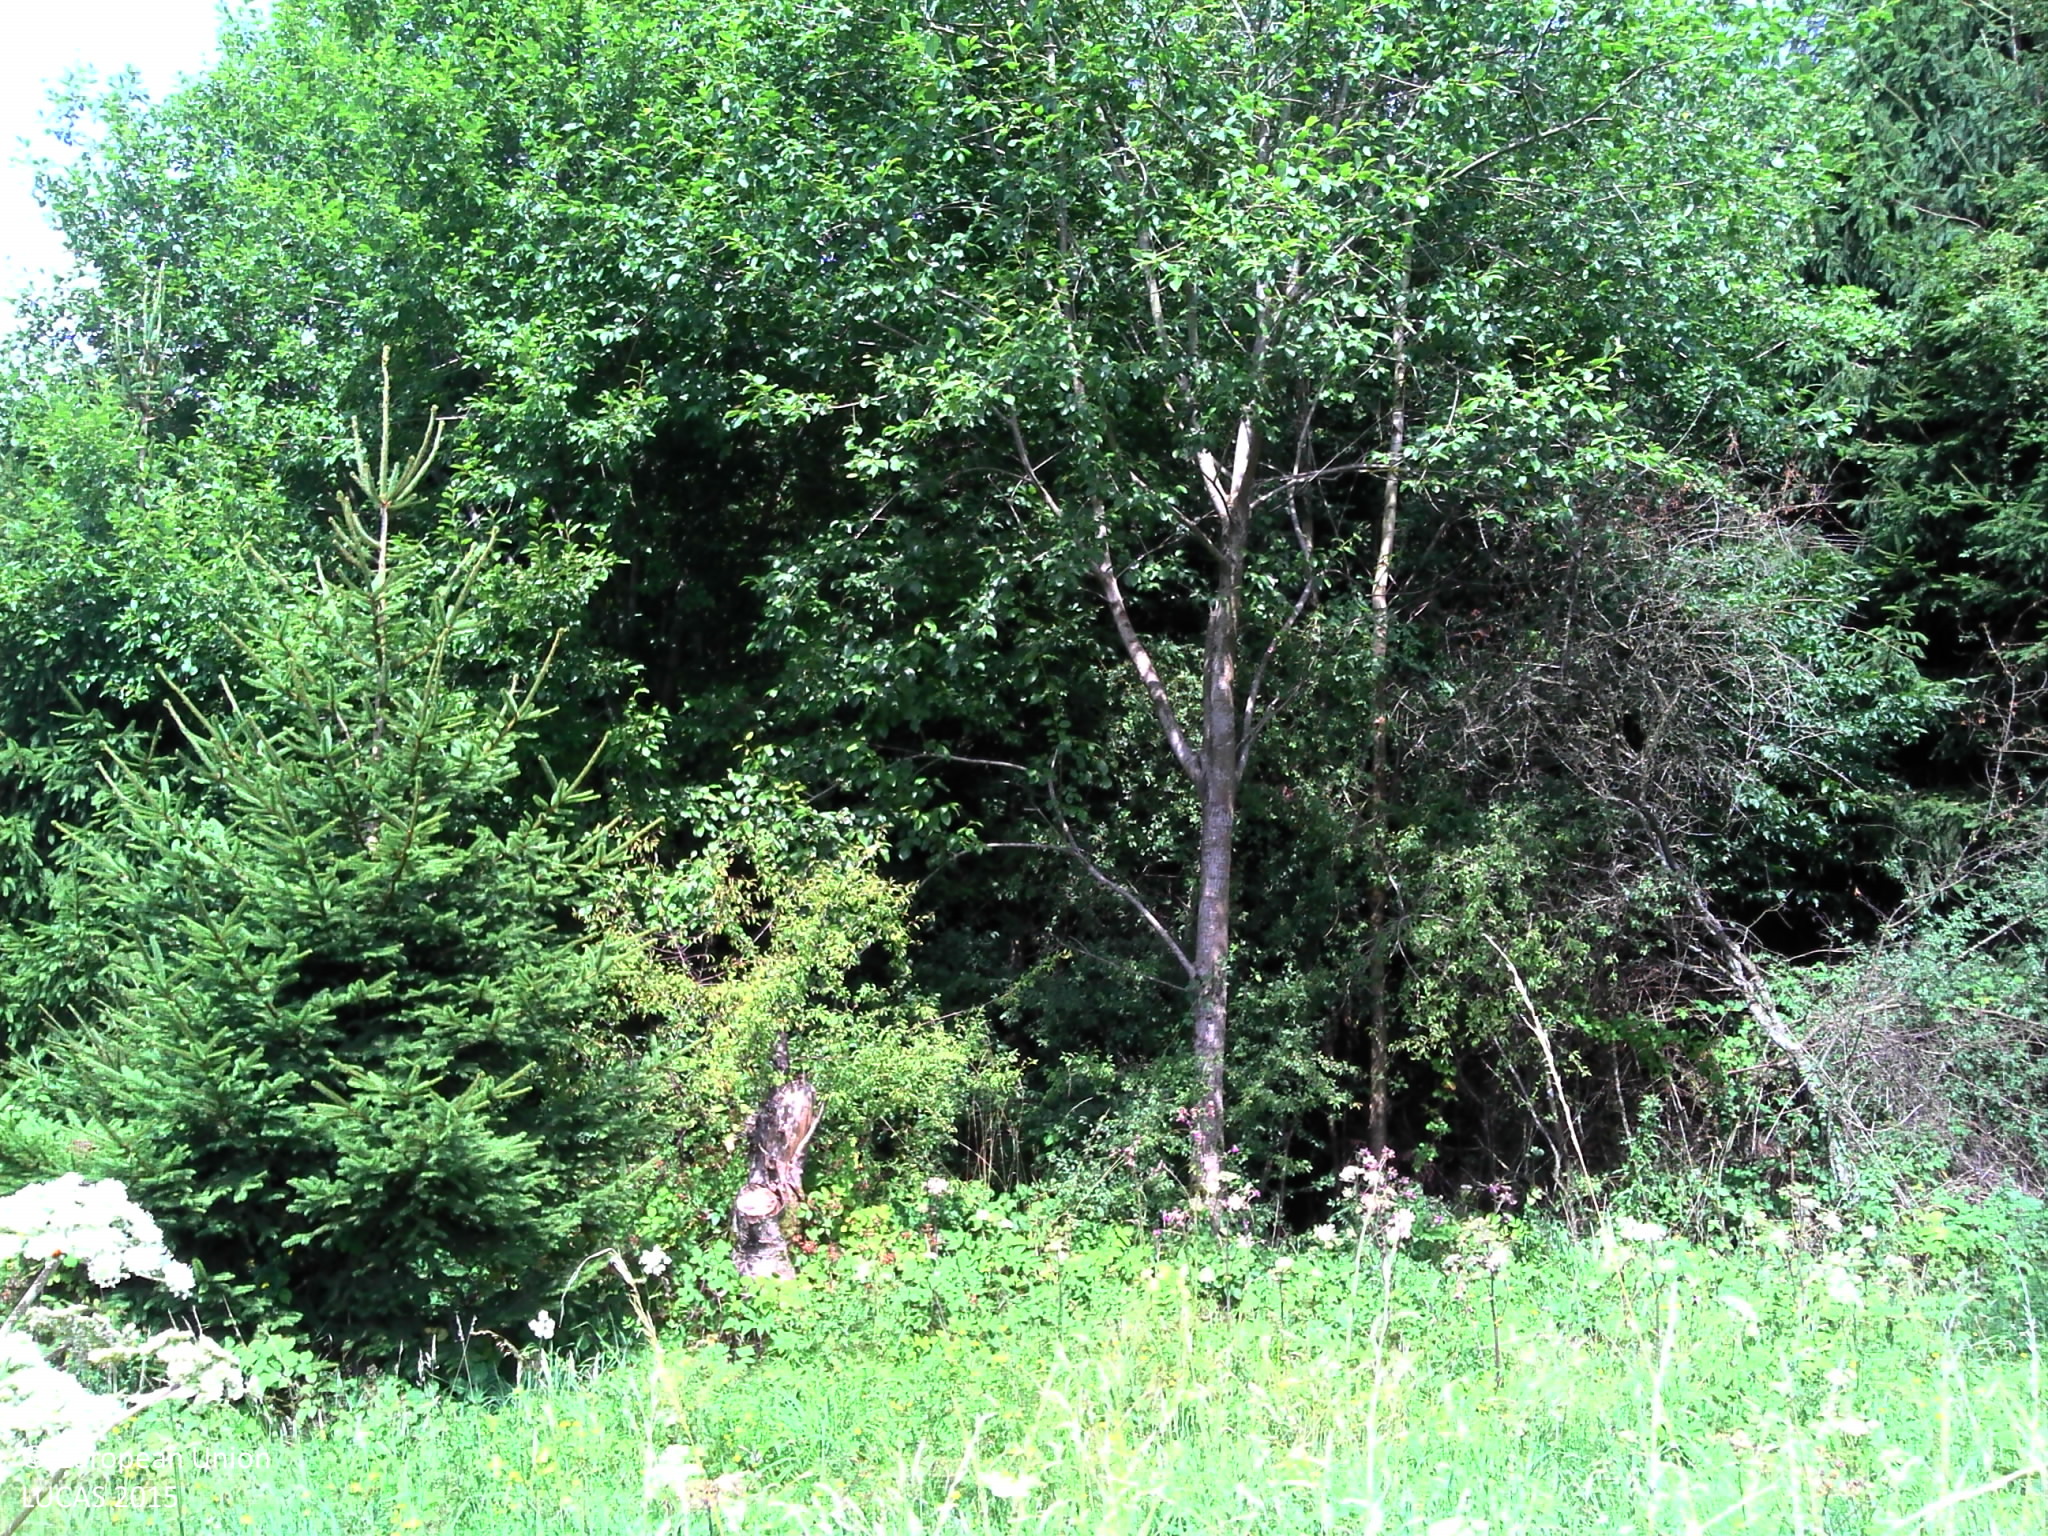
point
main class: Woodland
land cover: Broadleaved woodland
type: mesophytic deciduous forest
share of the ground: > 75 %
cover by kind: broadleaved forest trees 85 %, herbaceous plants 10 %, lichens and mosses 5 %
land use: Forestry
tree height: > 5 m
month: August
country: FR
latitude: 49.9980
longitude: 4.1496
